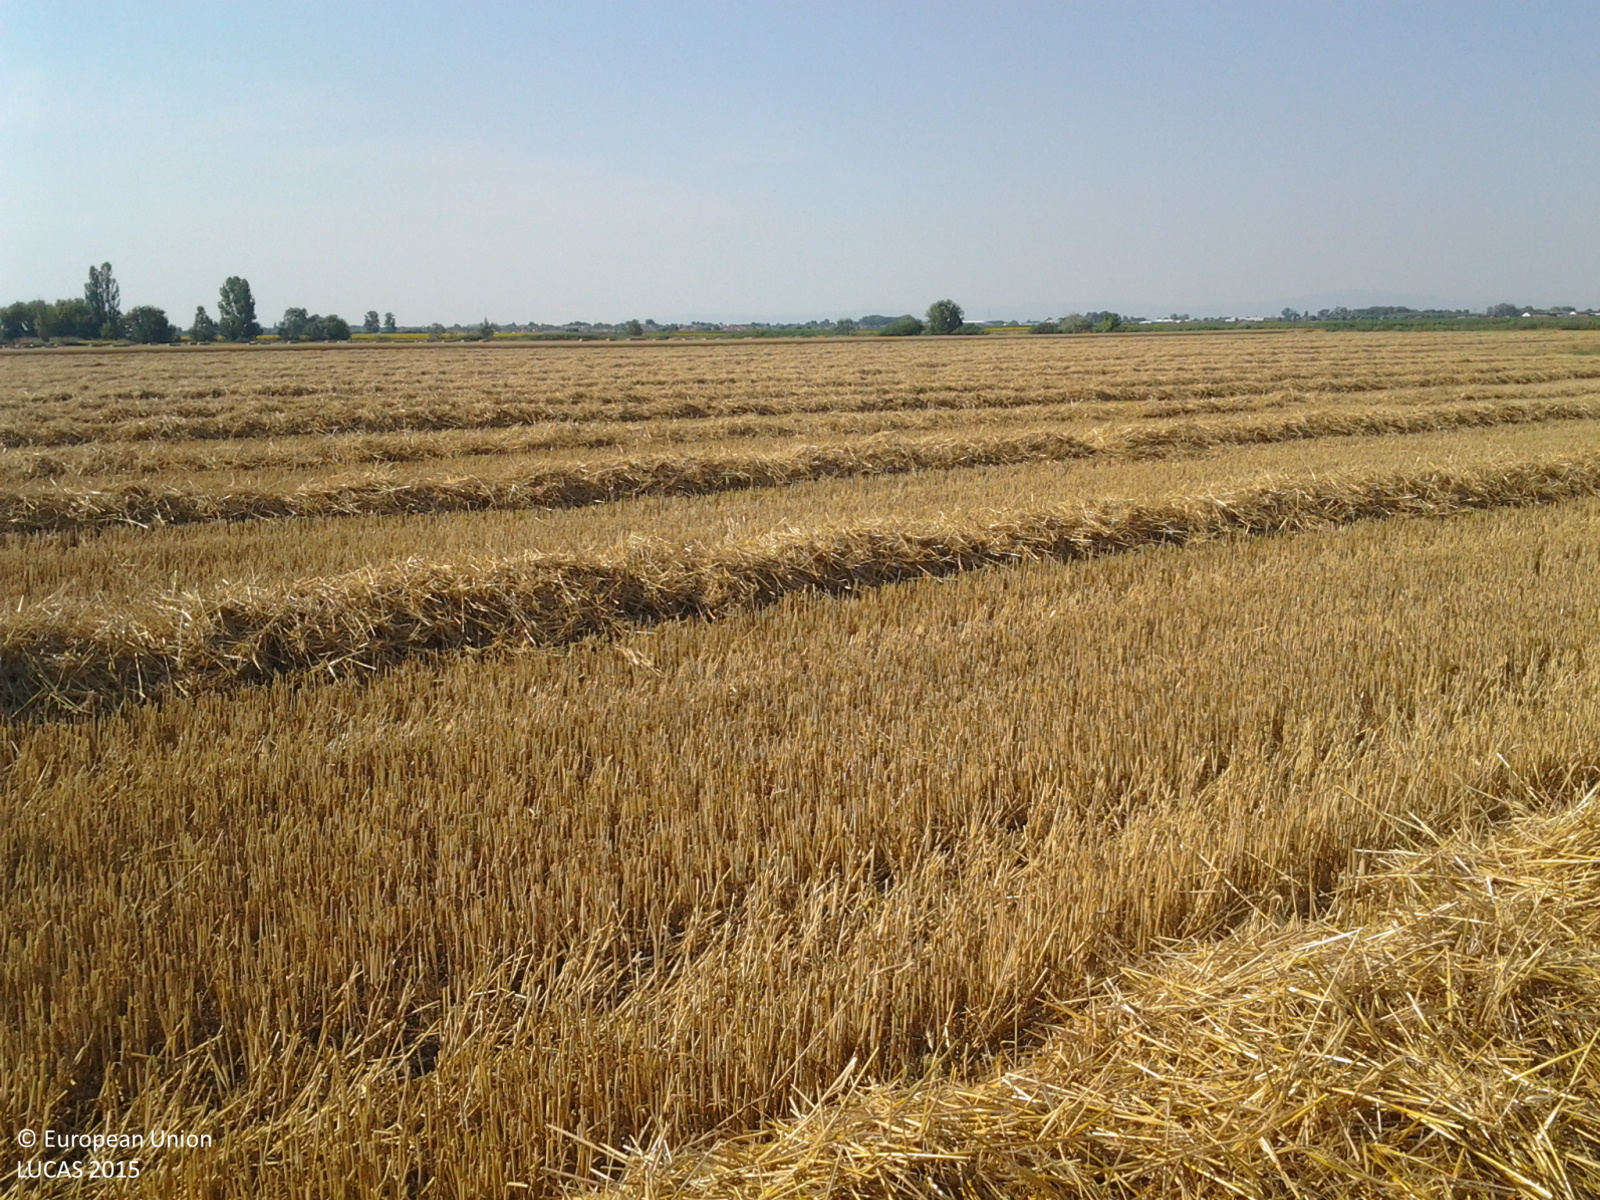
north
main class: Cropland
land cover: Triticale
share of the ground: > 75 %
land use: Agriculture (excluding fallow land and kitchen gardens)
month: July
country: HU
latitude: 47.4654
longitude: 19.9353
